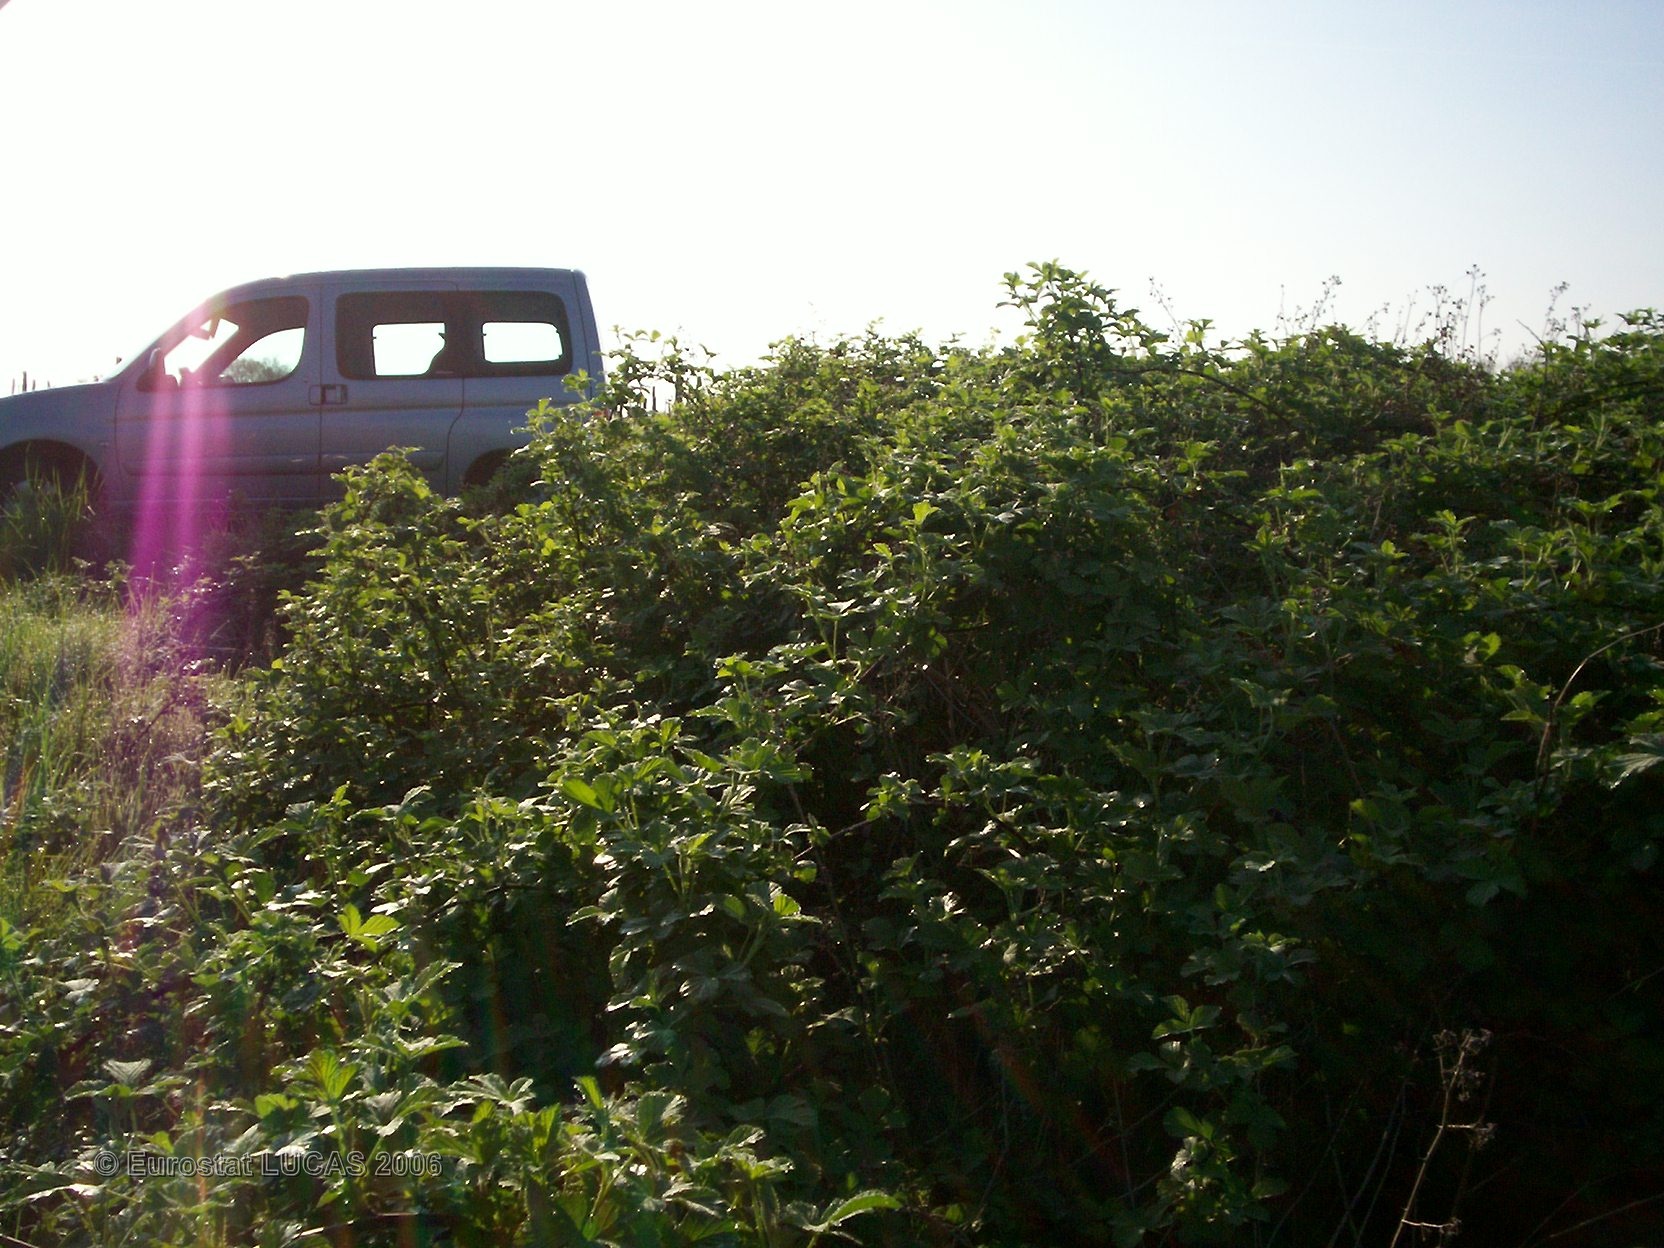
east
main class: Grassland
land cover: Grassland with sparse tree/shrub cover
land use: Unused
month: April
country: FR
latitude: 45.5198
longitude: 0.6037
